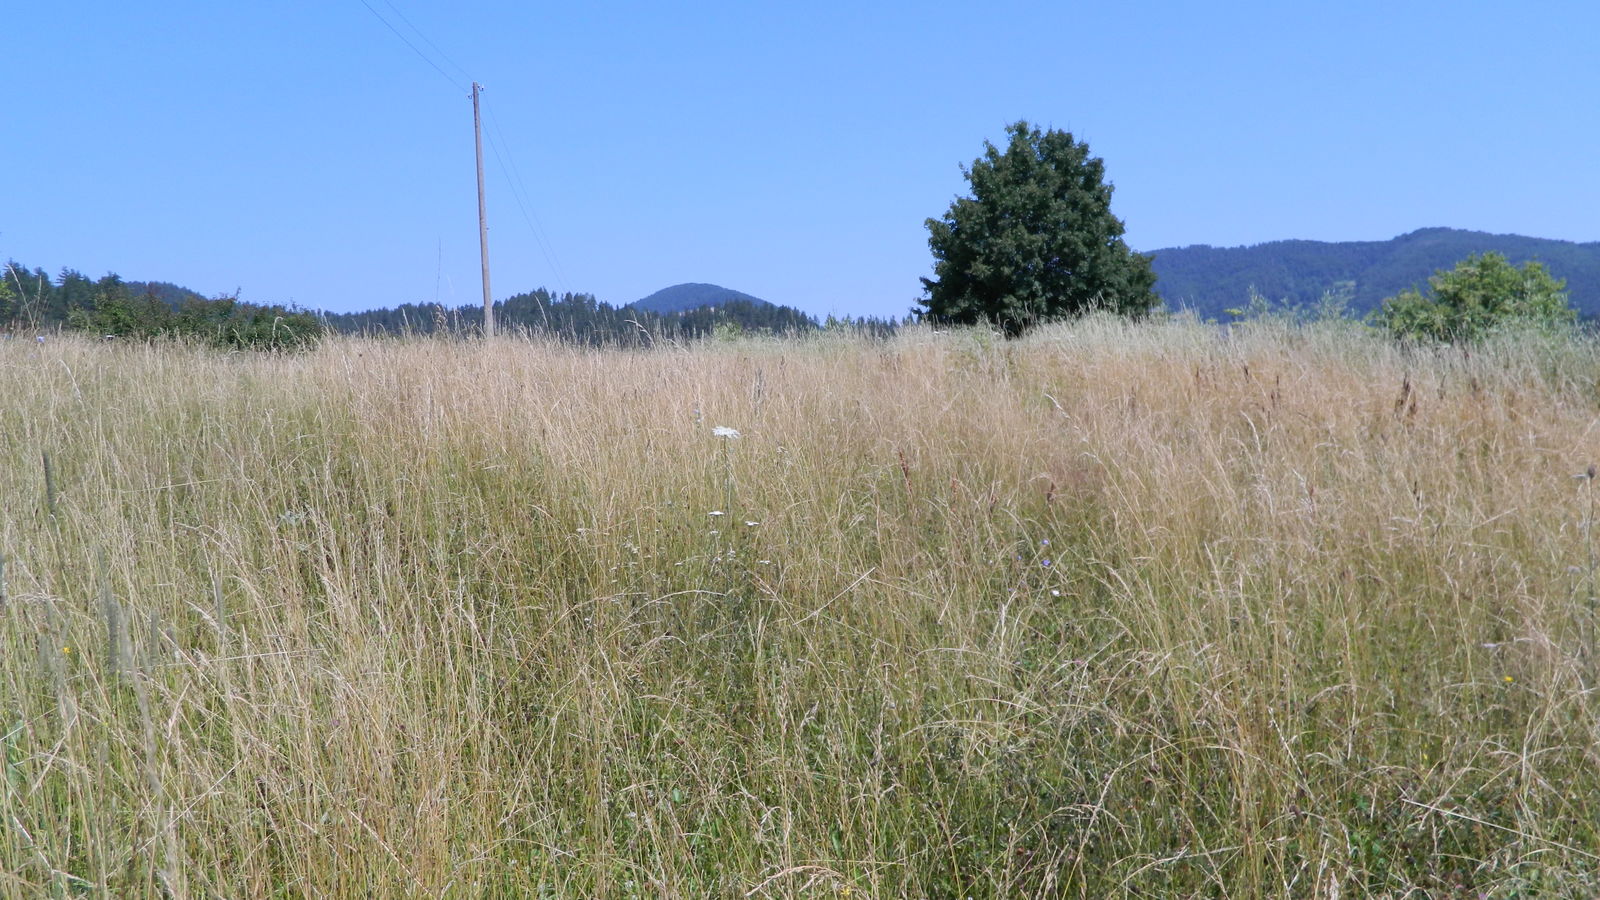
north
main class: Grassland
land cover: Grassland without tree/shrub cover
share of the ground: > 75 %
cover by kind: herbaceous plants 100 %
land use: Agriculture (excluding fallow land and kitchen gardens)
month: July
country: BG
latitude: 41.5272
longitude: 24.7733
